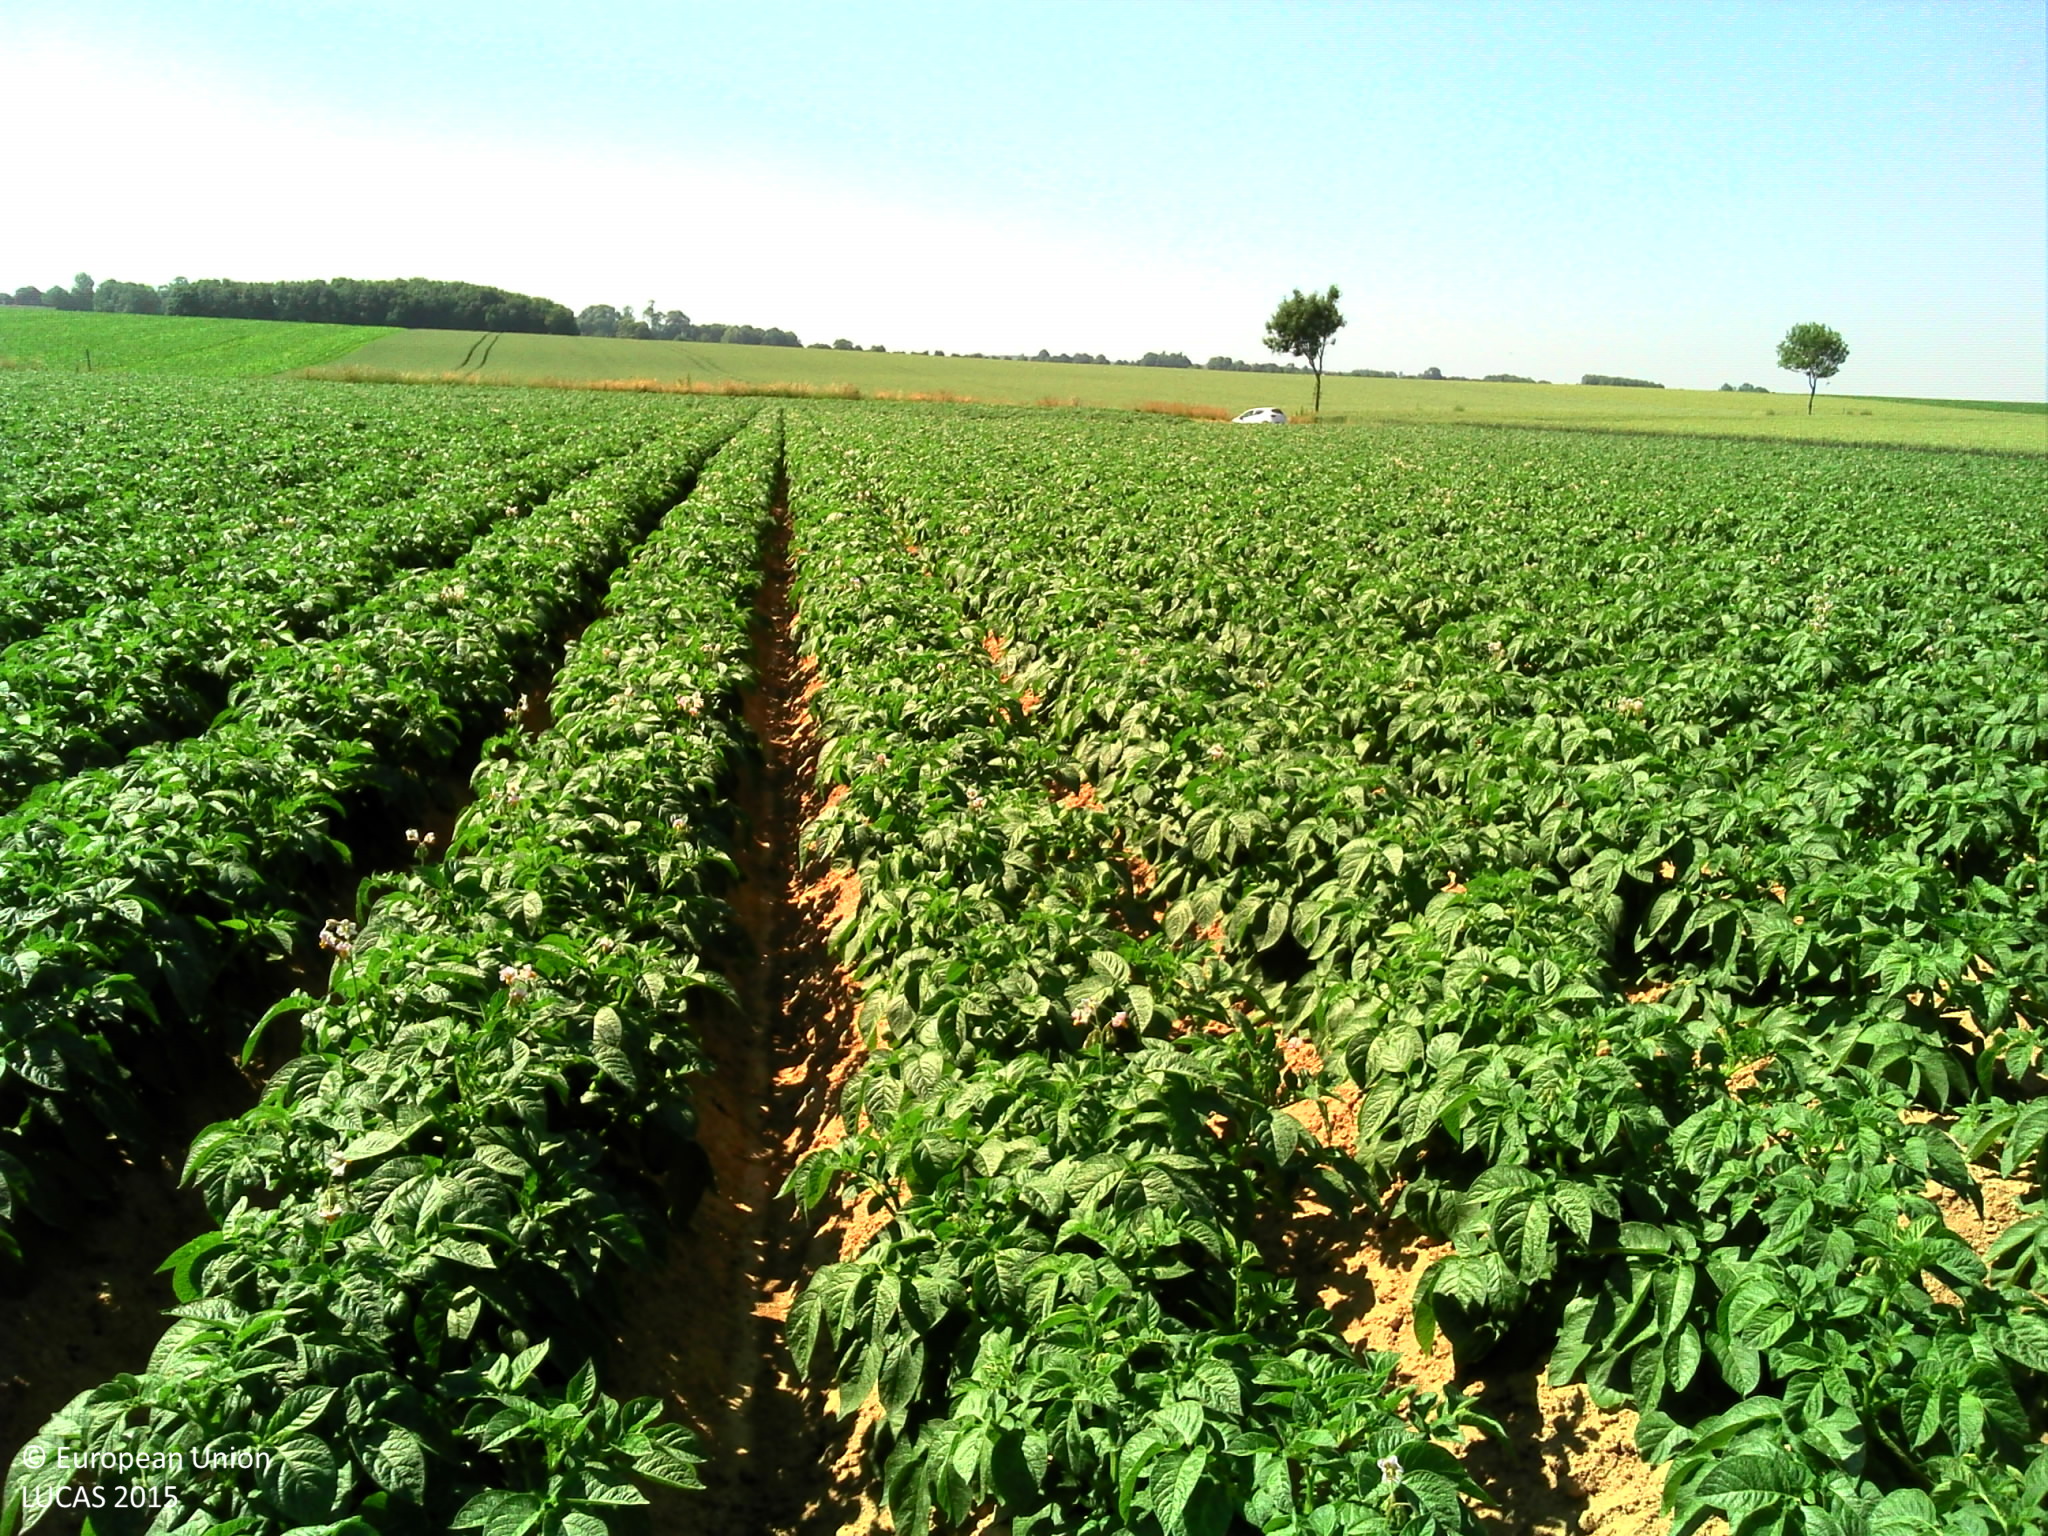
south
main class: Cropland
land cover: Potatoes
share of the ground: > 75 %
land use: Agriculture (excluding fallow land and kitchen gardens)
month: June
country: FR
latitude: 50.3343
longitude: 2.4992
